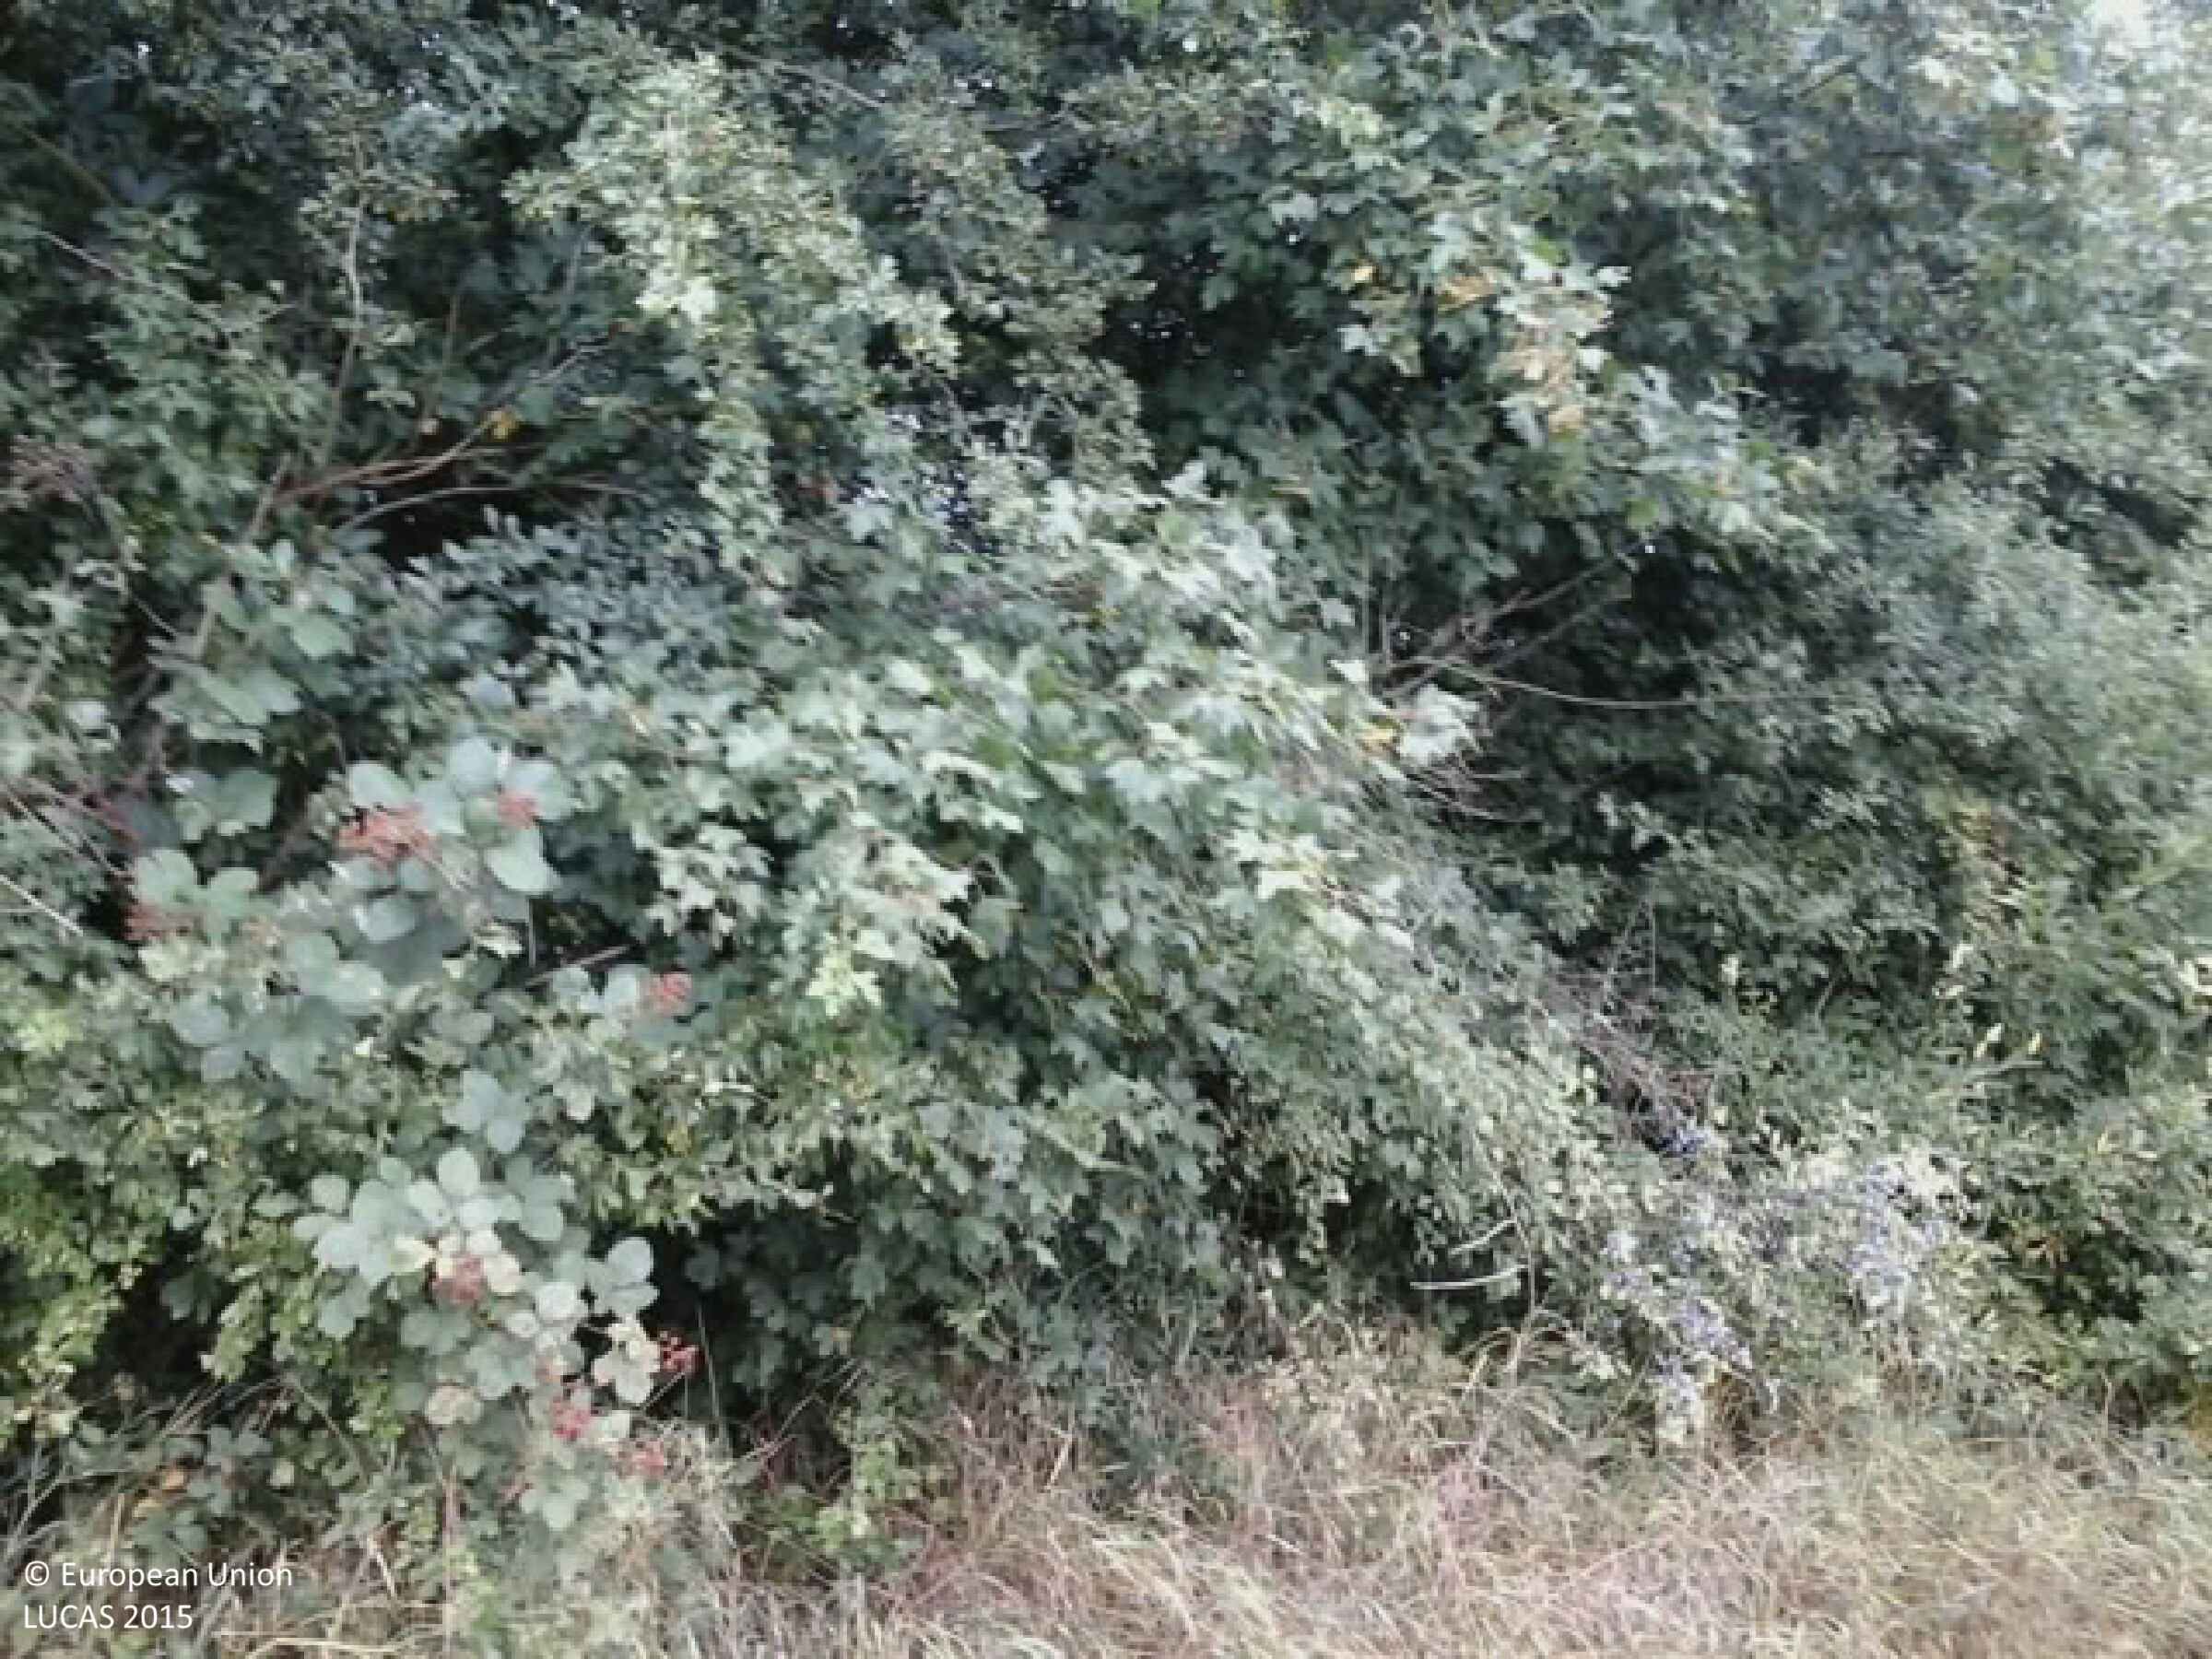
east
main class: Cropland
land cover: Maize
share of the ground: > 75 %
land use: Agriculture (excluding fallow land and kitchen gardens)
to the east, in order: Maize; Shrubland with sparse tree cover; Maize; Grassland with sparse tree/shrub cover; Broadleaved woodland; Maize
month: August
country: HU
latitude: 46.2176
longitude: 17.9527
